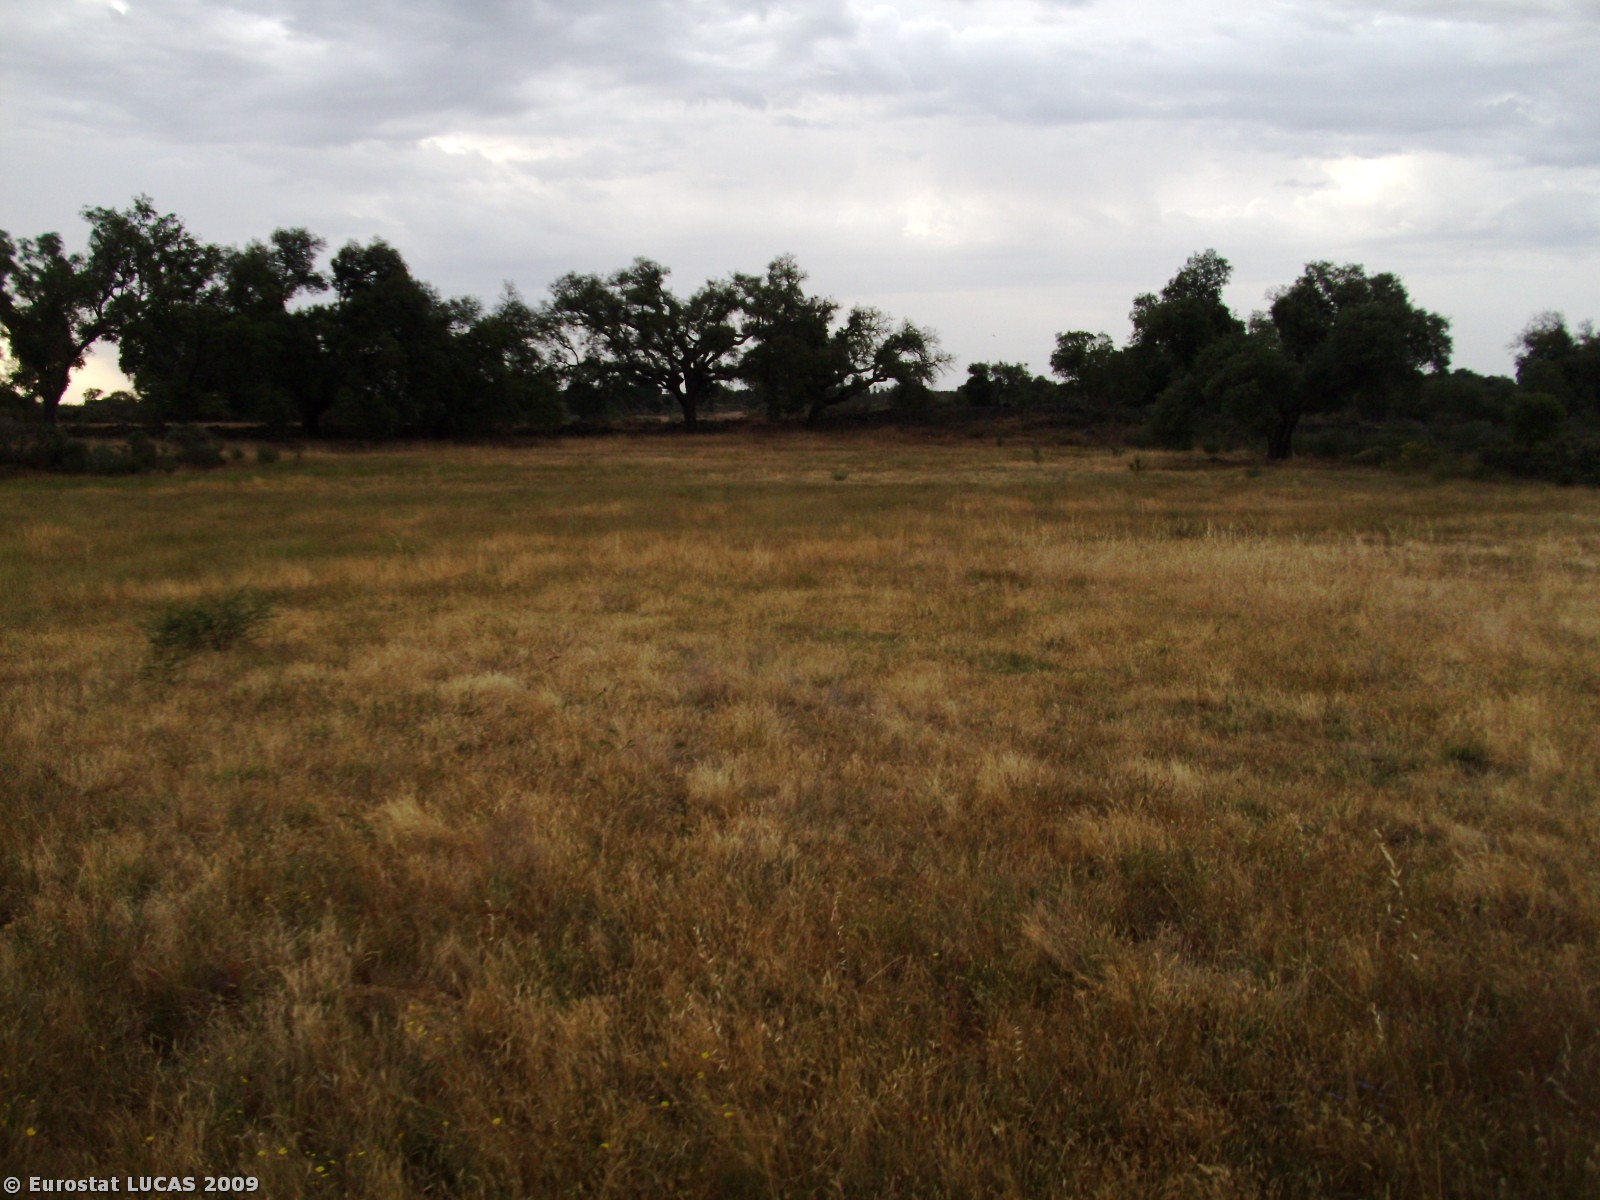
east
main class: Grassland
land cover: Spontaneously vegetated surfaces
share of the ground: > 75 %
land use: Fallow land
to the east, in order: Spontaneously vegetated surfaces; Broadleaved woodland; Fences; Dry stone walls; Tracks; Fences; Bare land; Fences; Spontaneously vegetated surfaces
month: June
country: PT
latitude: 39.9178
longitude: -7.4976
